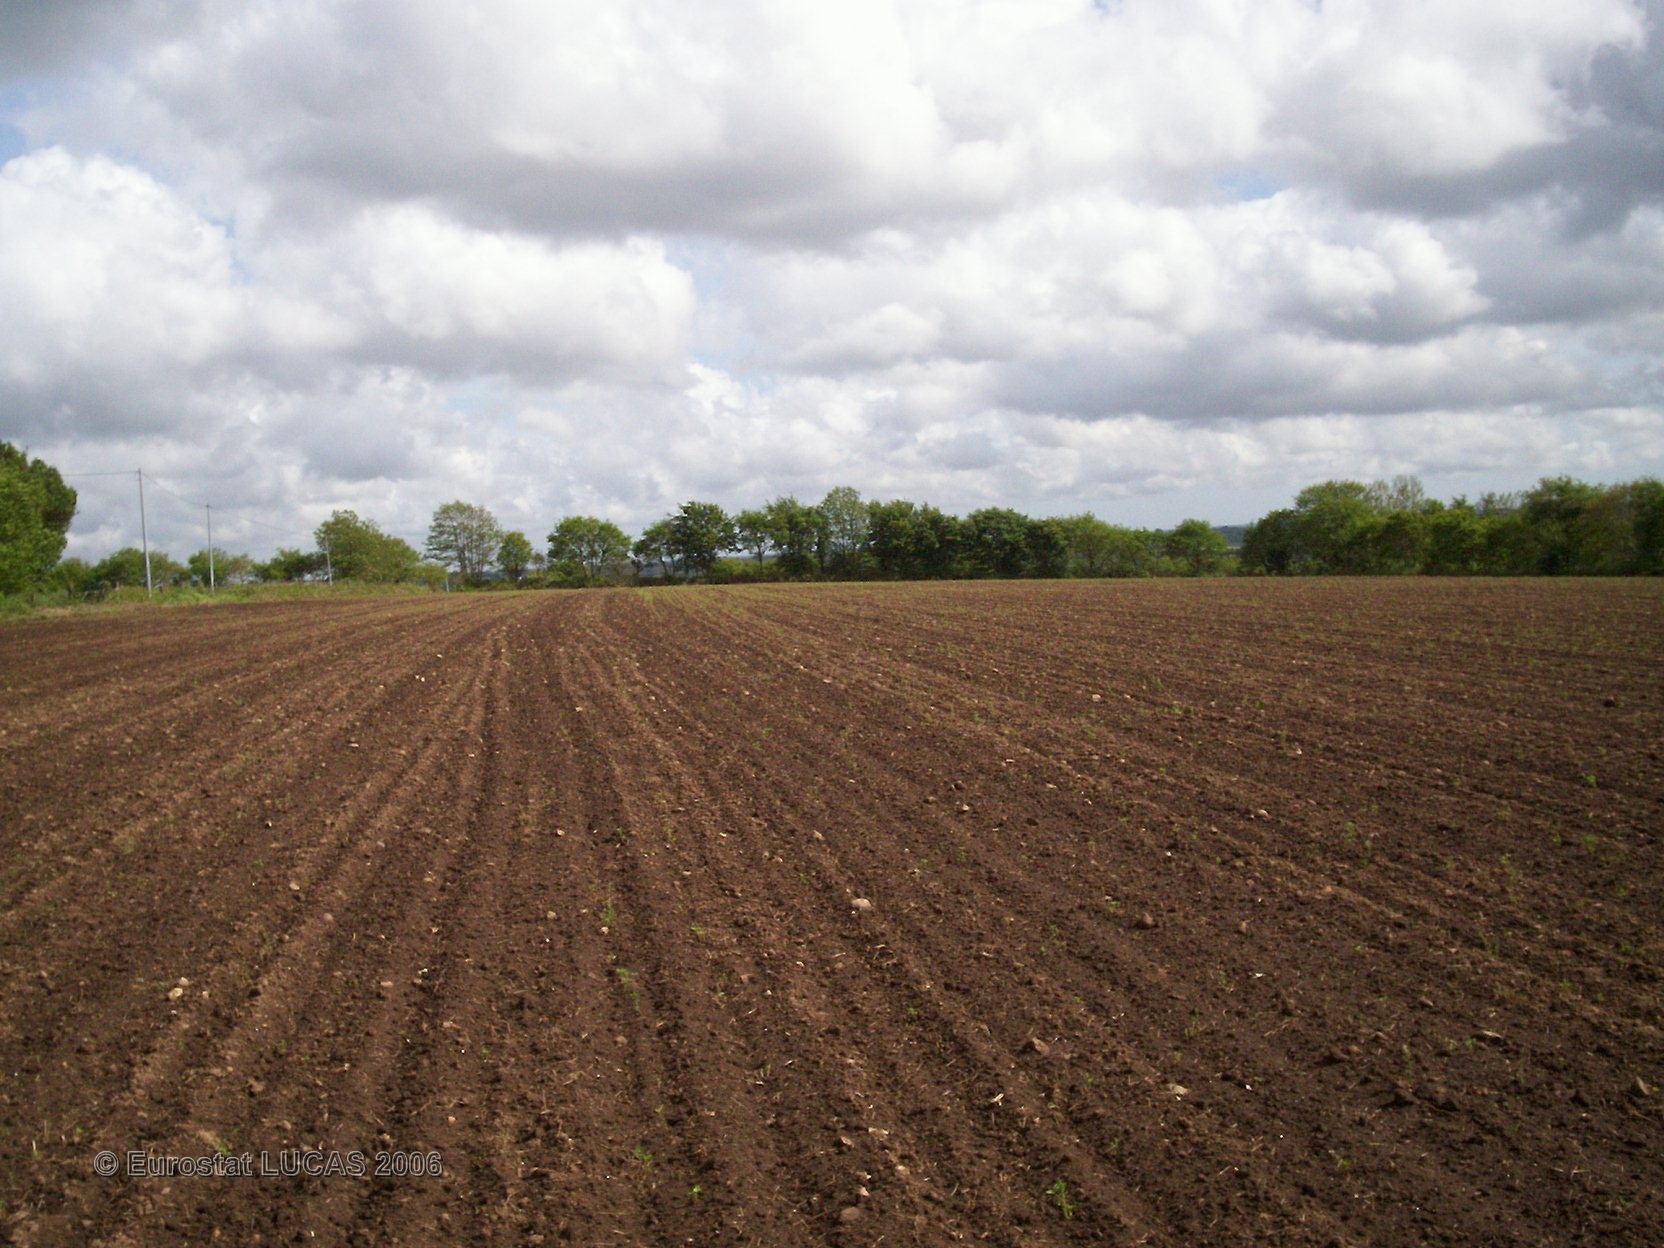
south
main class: Cropland
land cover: Other cereals
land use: Agriculture (excluding fallow land and kitchen gardens)
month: June
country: FR
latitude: 48.0829
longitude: -3.9254
